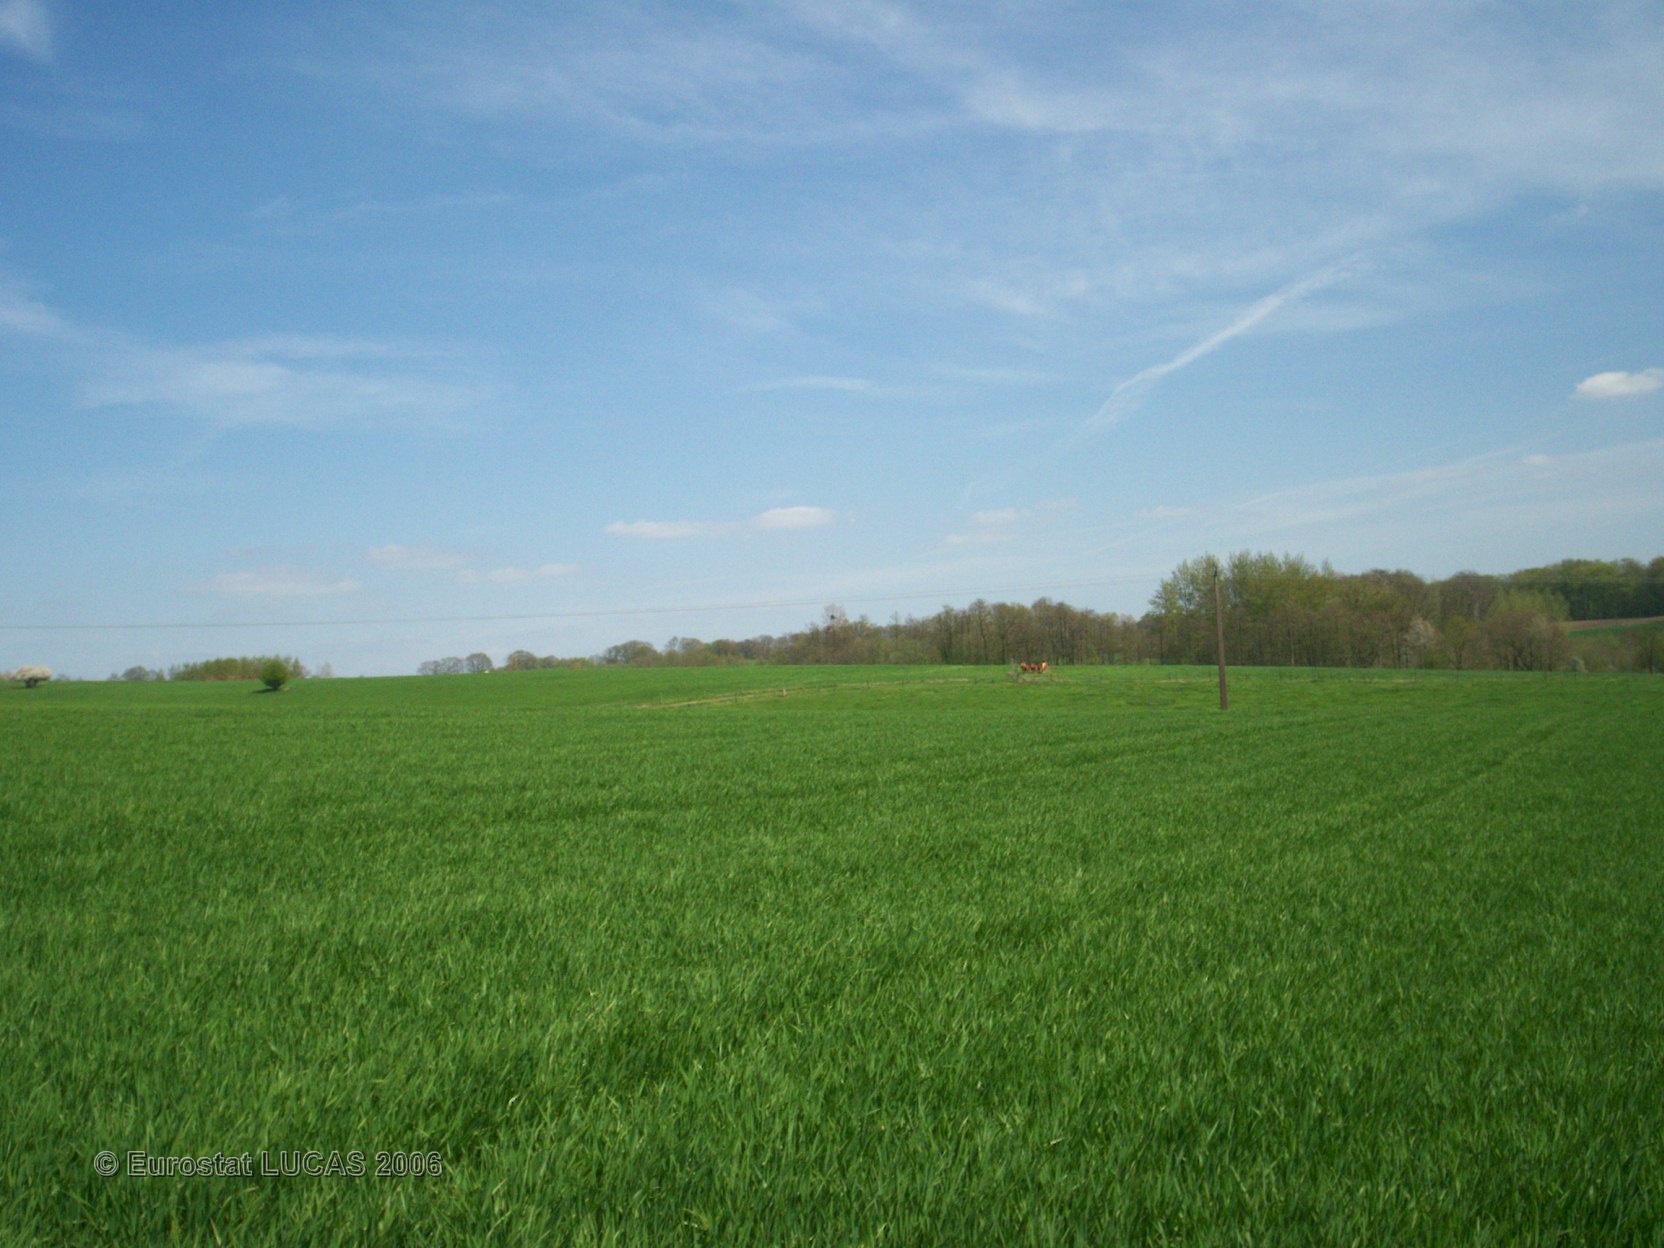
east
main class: Cropland
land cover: Common wheat
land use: Agriculture (excluding fallow land and kitchen gardens)
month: April
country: FR
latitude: 49.7376
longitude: 4.3483
